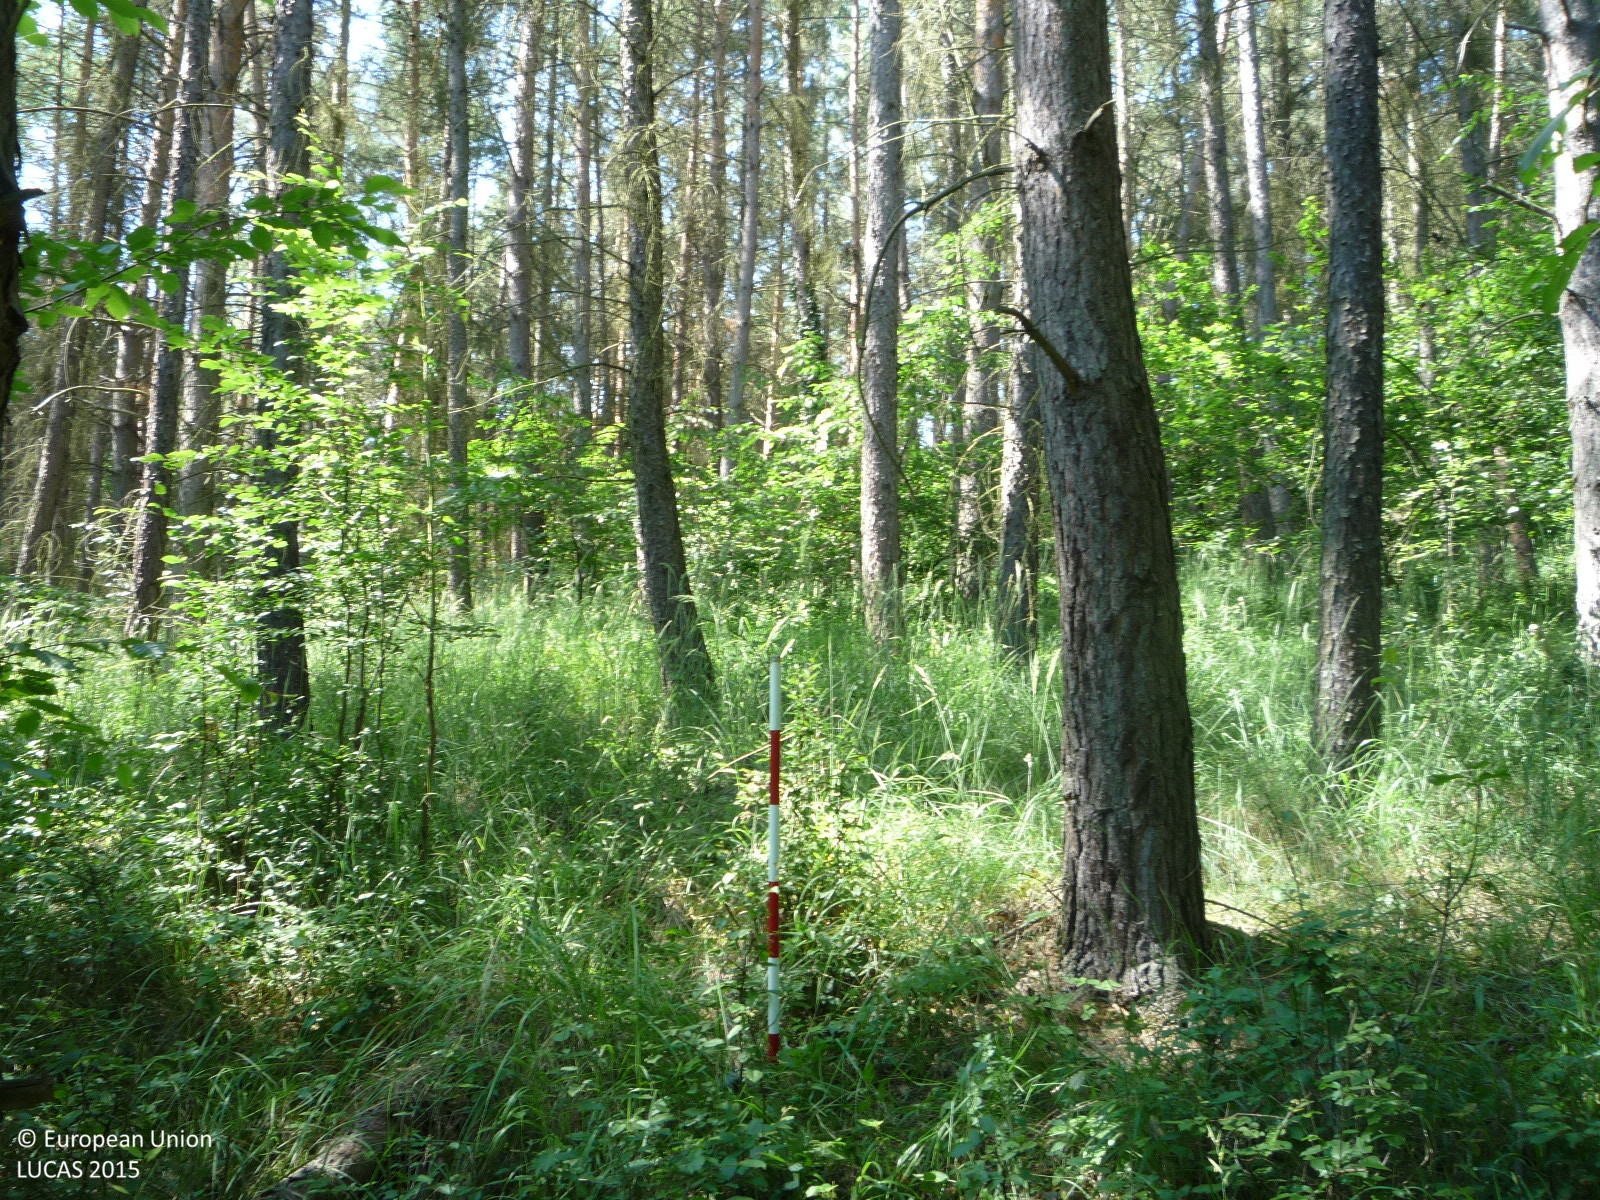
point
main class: Woodland
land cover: Other coniferous woodland
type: hemiboreal forest and nemoral coniferous forest and mixed broadleaved-coniferous forest
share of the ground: > 75 %
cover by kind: coniferous forest trees 90 %, broadleaved forest trees 5 %, herbaceous plants 5 %
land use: Forestry
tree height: > 5 m
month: July
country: CZ
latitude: 50.4727
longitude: 14.5248
